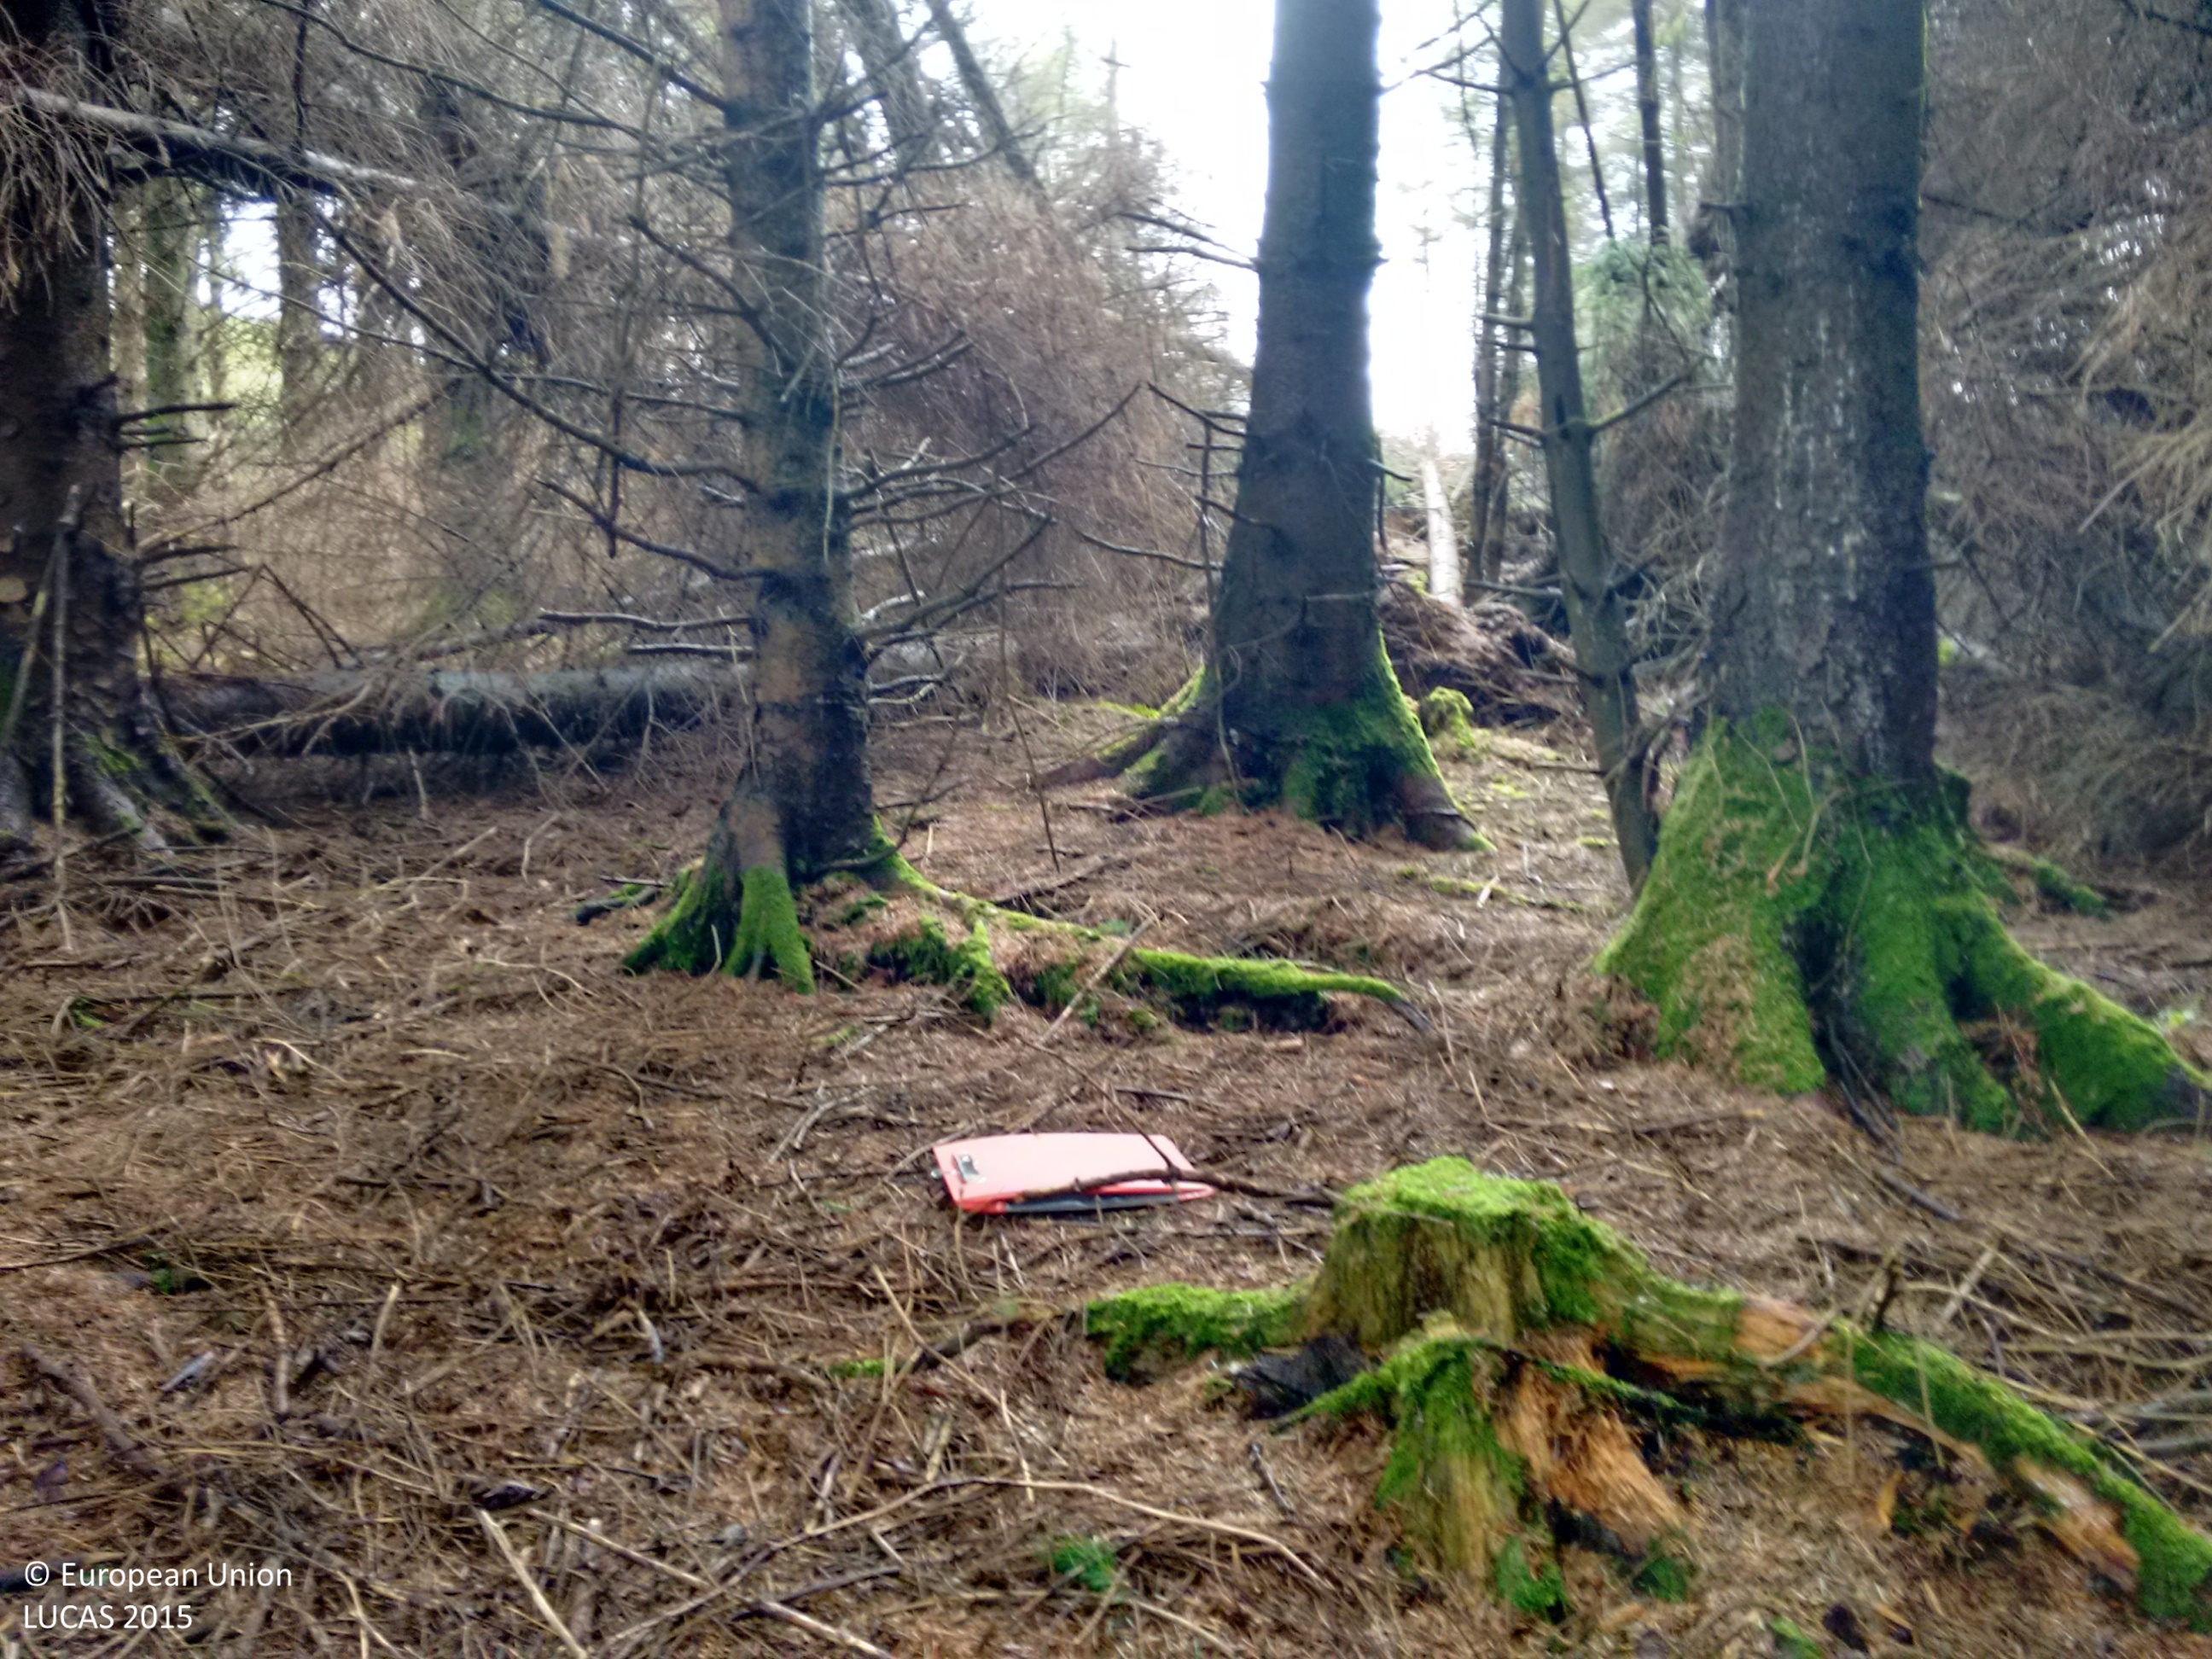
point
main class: Woodland
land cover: Spruce dominated coniferous woodland
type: exotic forest
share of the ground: > 75 %
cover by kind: coniferous forest trees 100 %
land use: Forestry
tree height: > 5 m
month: July
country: IE
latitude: 52.8714
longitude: -6.4533
